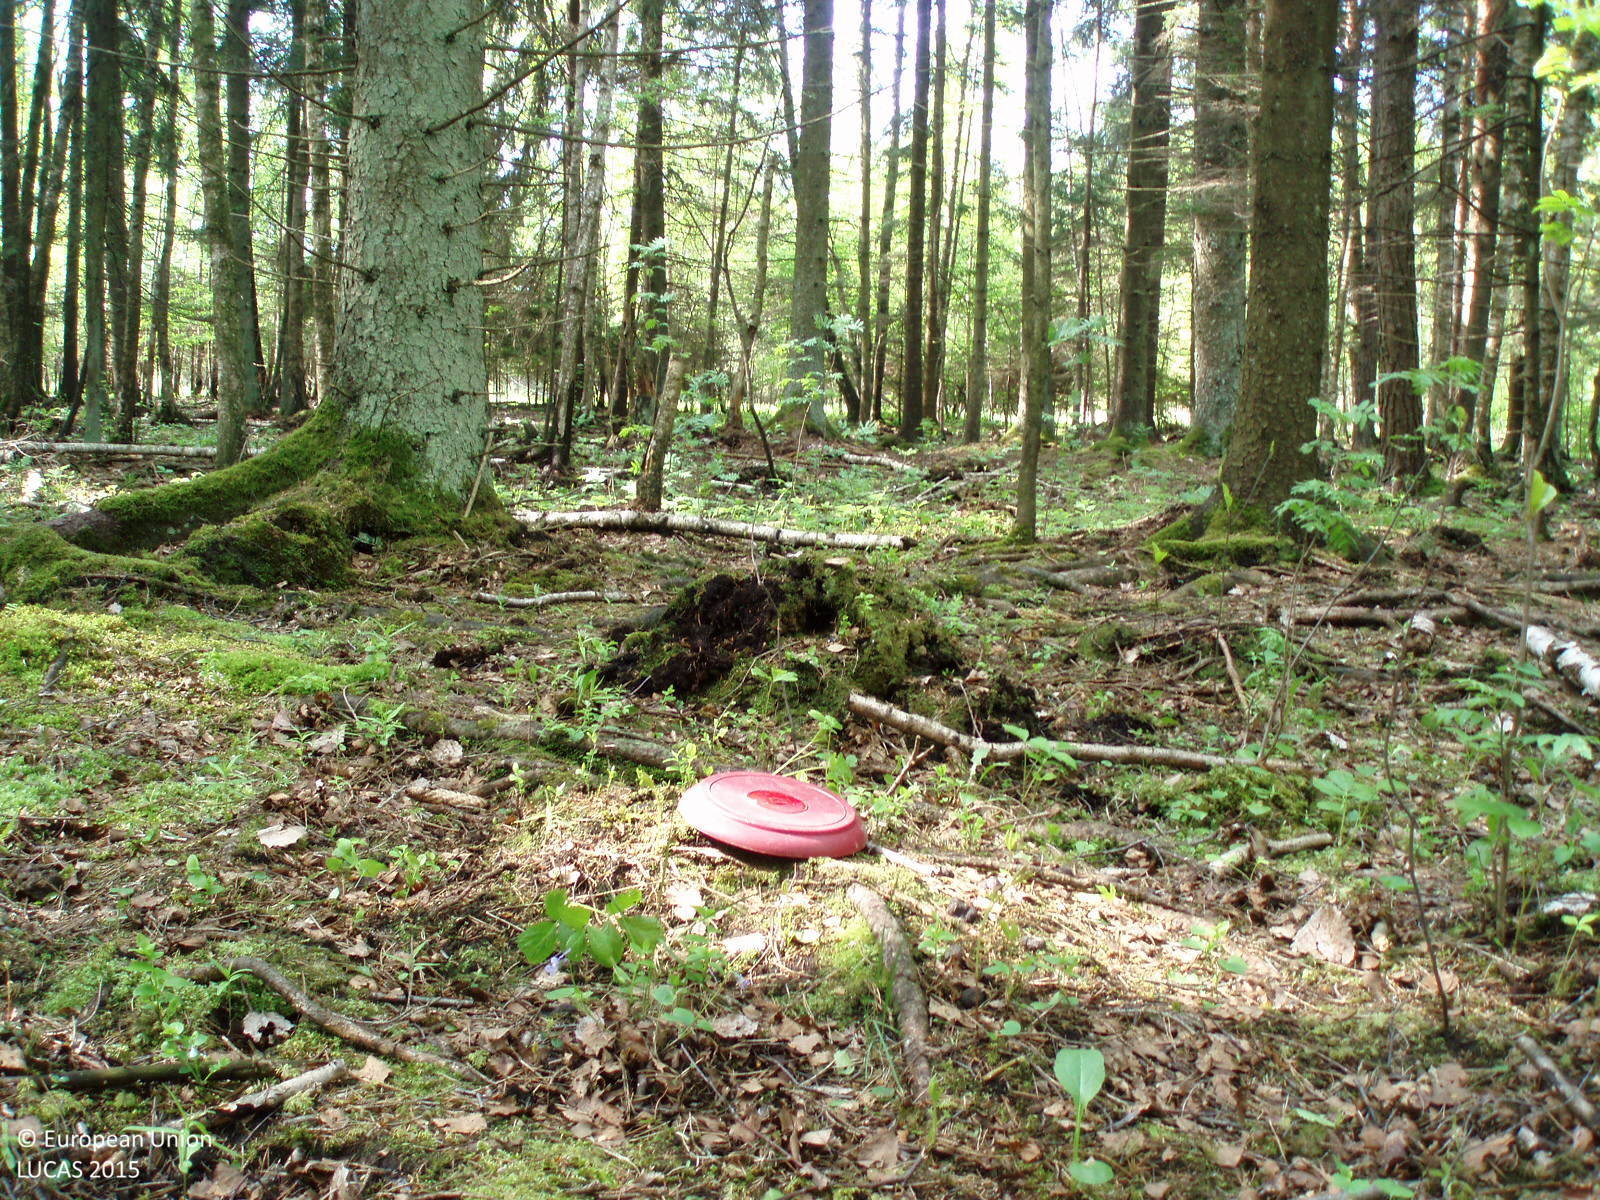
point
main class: Woodland
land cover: Spruce dominated mixed woodland
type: hemiboreal forest and nemoral coniferous forest and mixed broadleaved-coniferous forest
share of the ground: > 75 %
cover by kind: coniferous forest trees 50 %, broadleaved forest trees 50 %
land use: Forestry
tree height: > 5 m
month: May
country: LT
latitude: 56.3473
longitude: 22.5992
